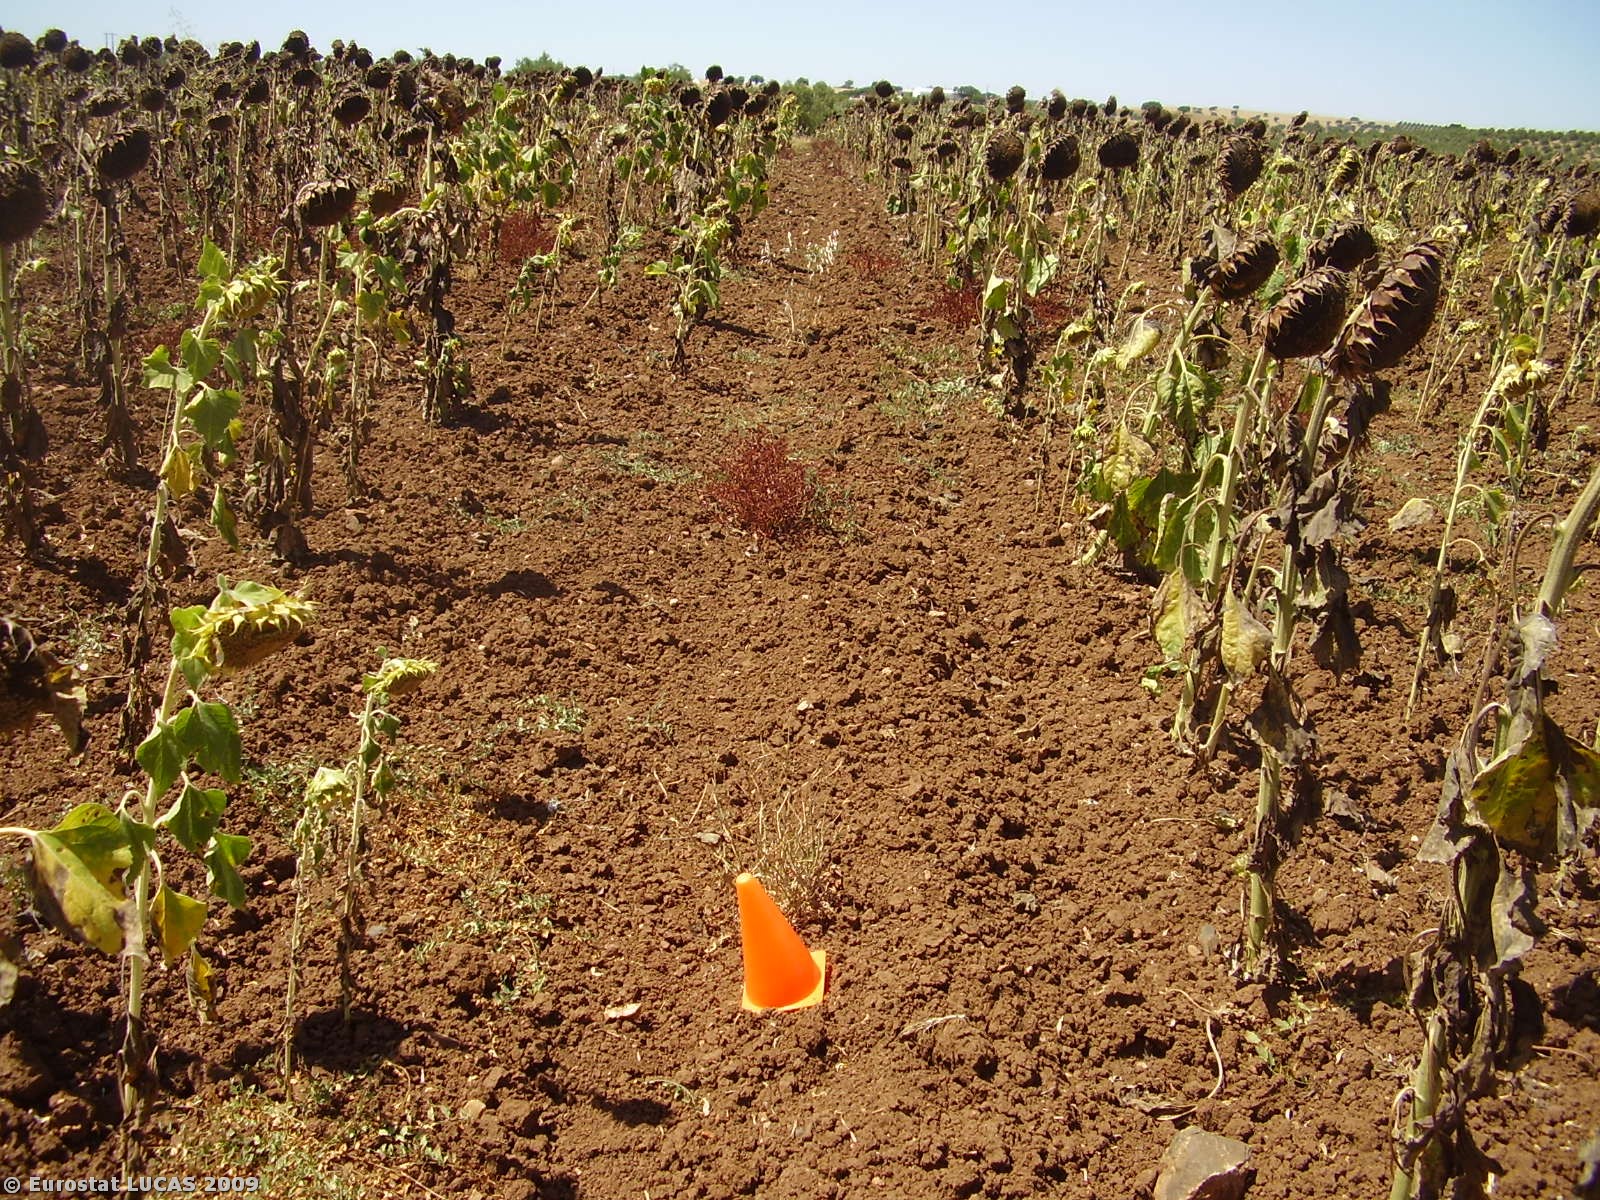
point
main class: Cropland
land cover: Sunflower
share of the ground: 10 - 25 %
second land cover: Spontaneously vegetated surfaces
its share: < 10 %
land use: Agriculture (excluding fallow land and kitchen gardens)
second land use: Fallow land
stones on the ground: < 10 %
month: July
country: PT
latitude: 38.0270
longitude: -7.8331
